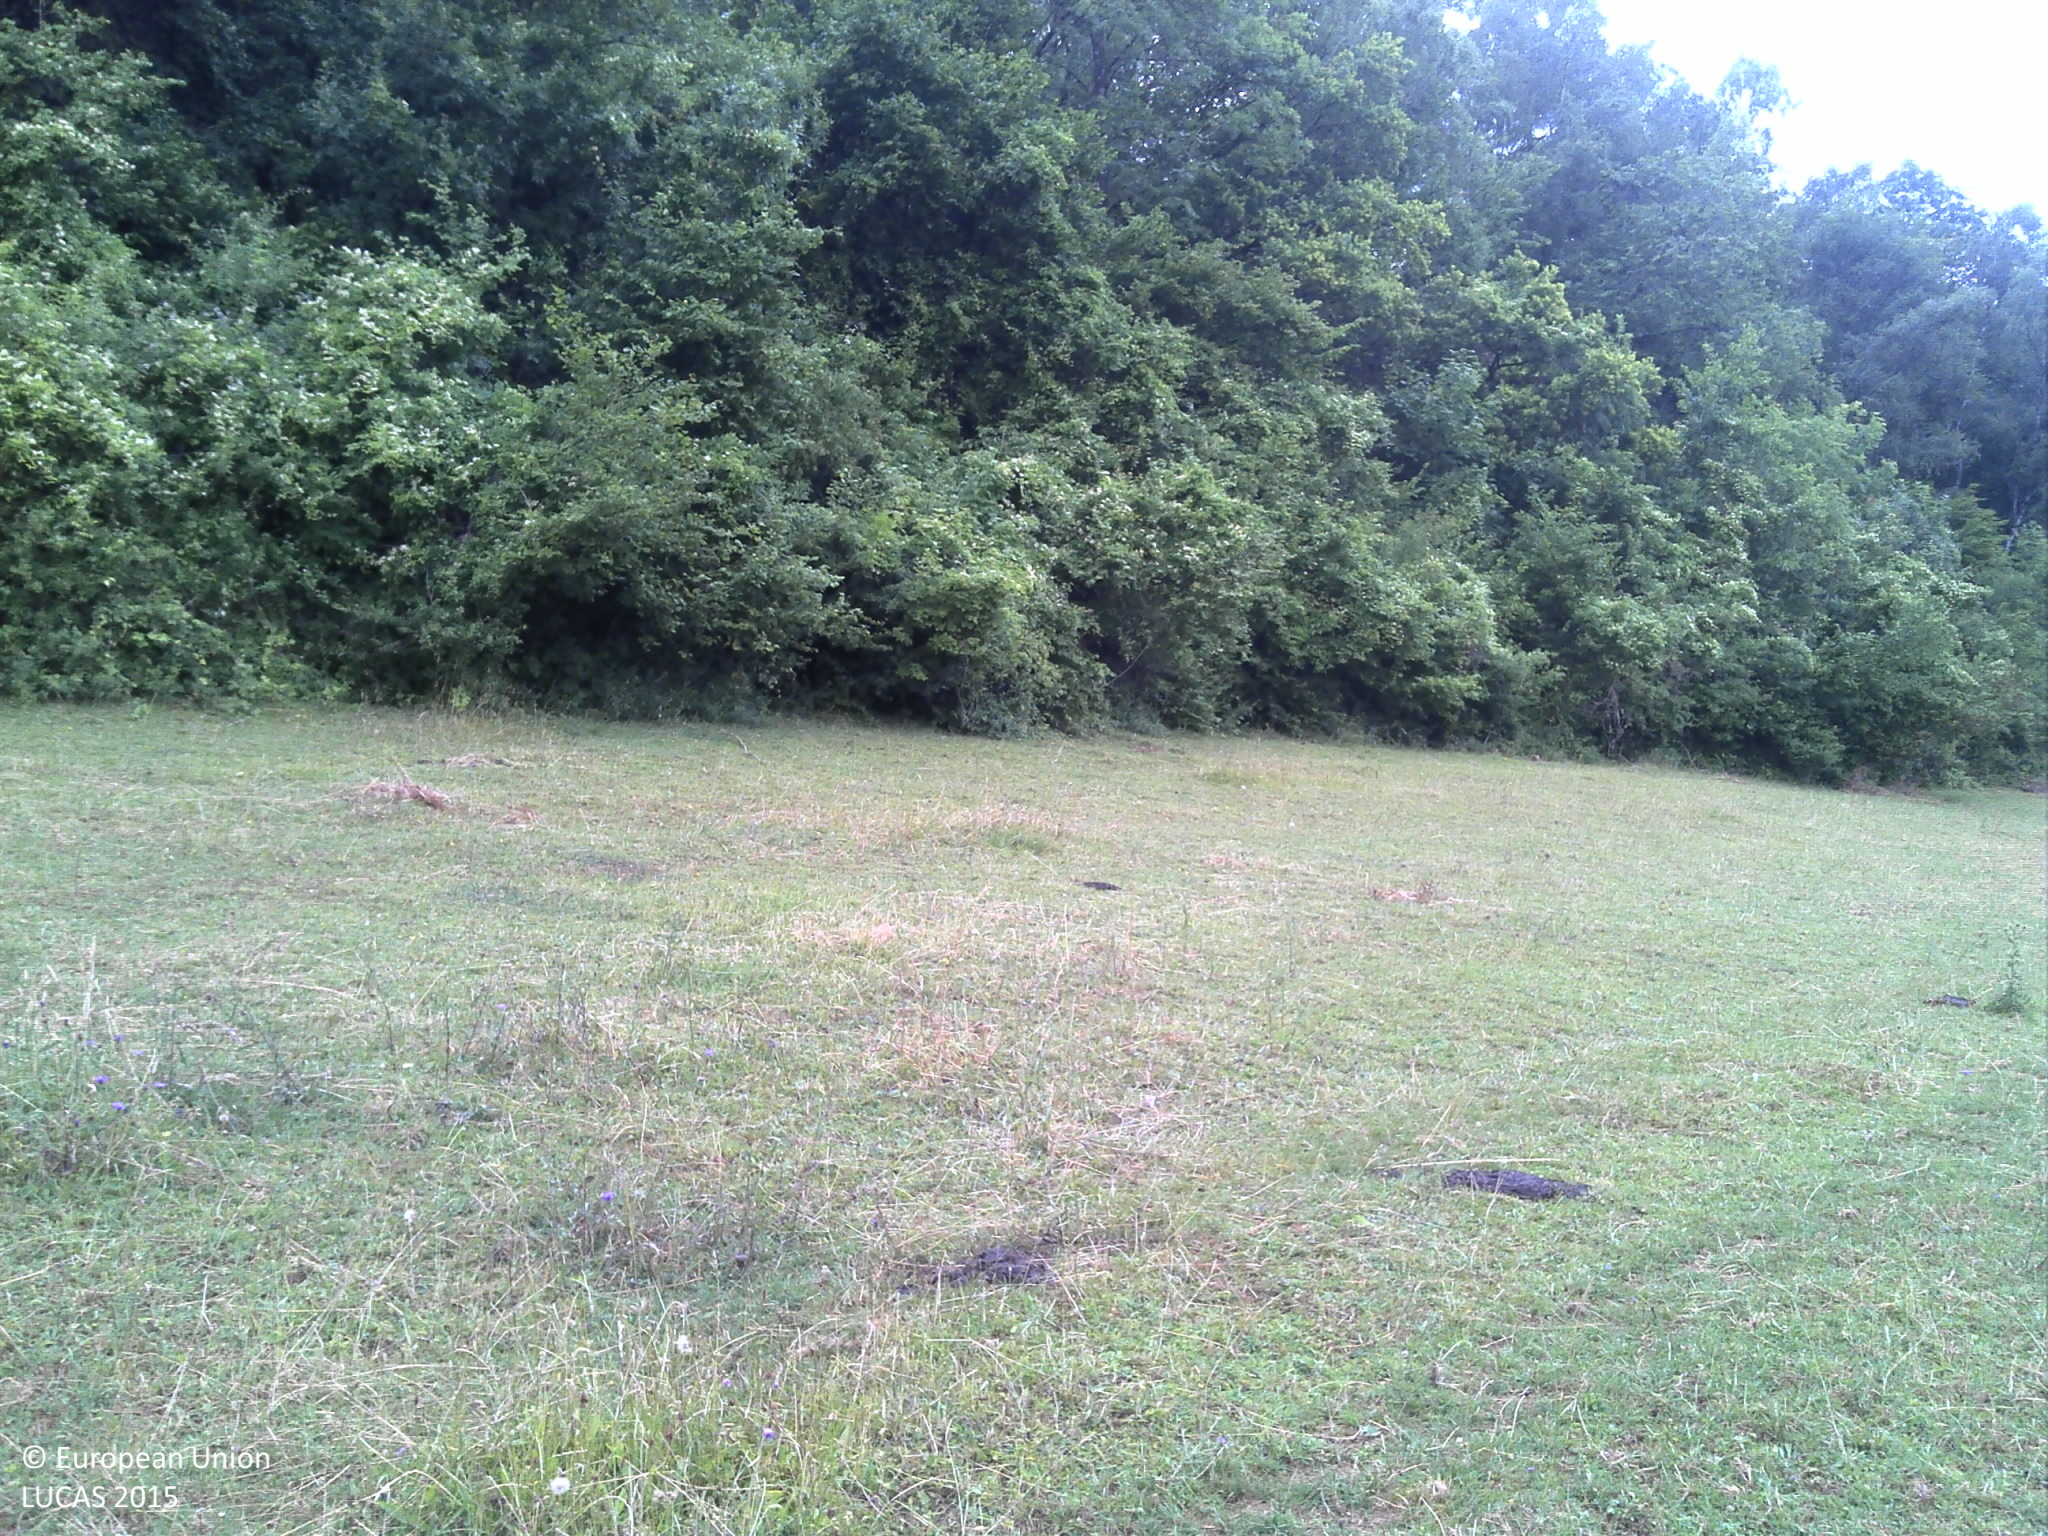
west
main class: Grassland
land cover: Grassland without tree/shrub cover
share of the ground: > 75 %
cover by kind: herbaceous plants 100 %
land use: Agriculture (excluding fallow land and kitchen gardens)
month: July
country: FR
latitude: 49.7498
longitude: 4.5975
